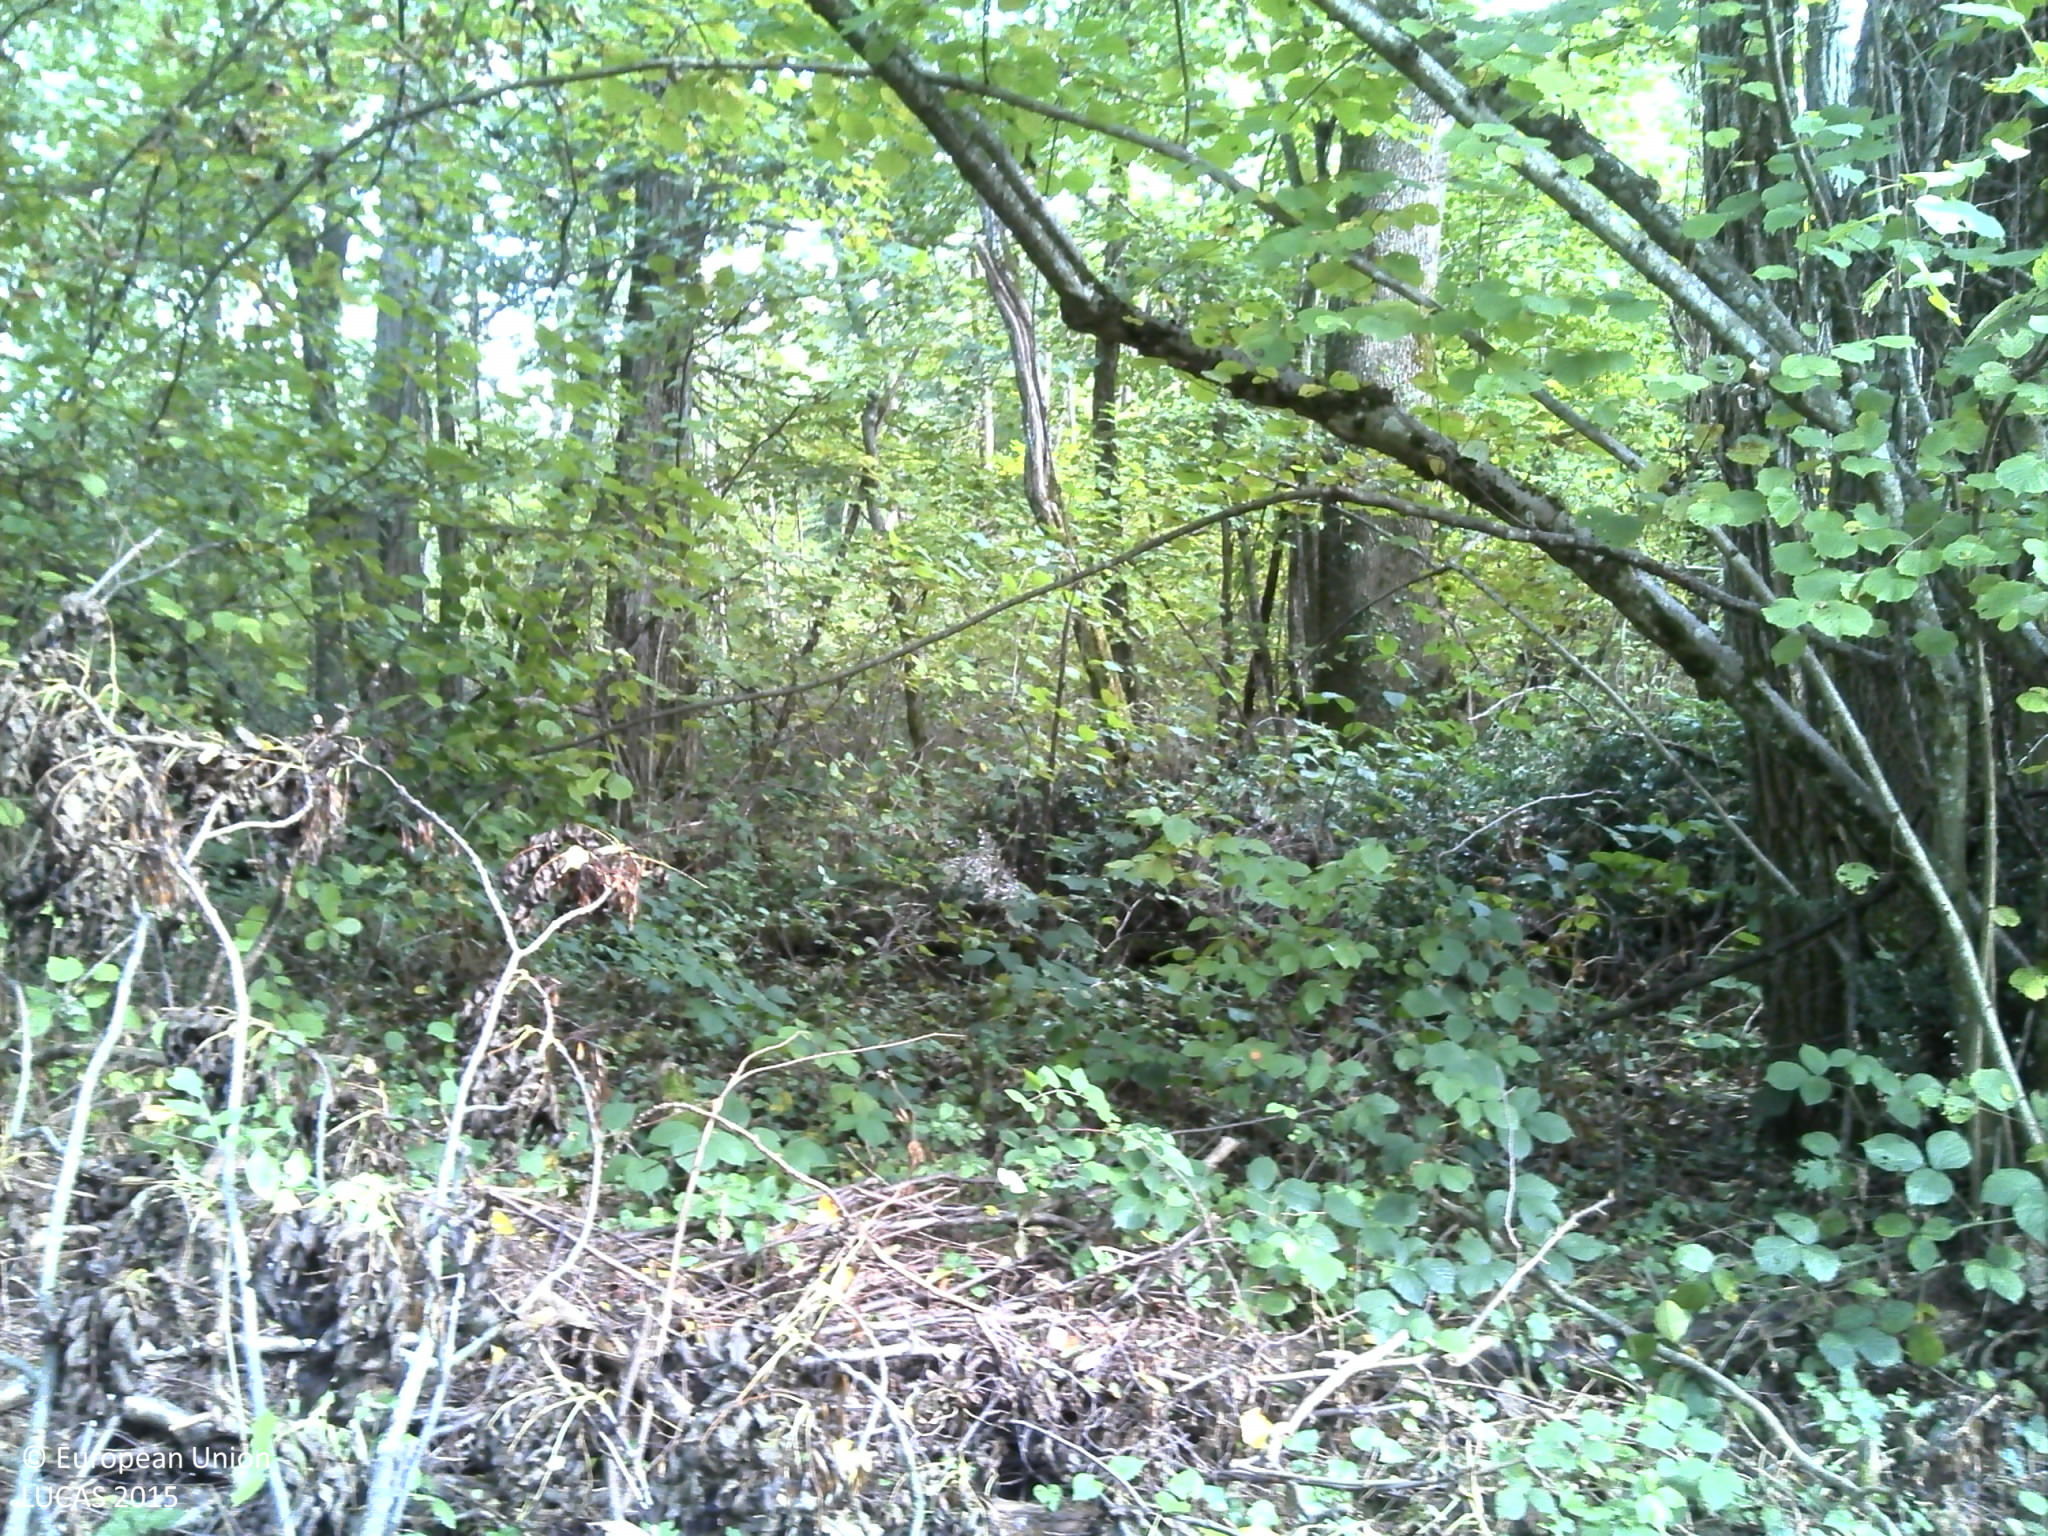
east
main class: Woodland
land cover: Broadleaved woodland
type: mesophytic deciduous forest
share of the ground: > 75 %
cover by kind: broadleaved forest trees 90 %, herbaceous plants 5 %, unconsolidated bare surface 5 %
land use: Forestry
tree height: > 5 m
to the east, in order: Broadleaved woodland; Tracks; Broadleaved woodland
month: October
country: FR
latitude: 45.9433
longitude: 5.3470
